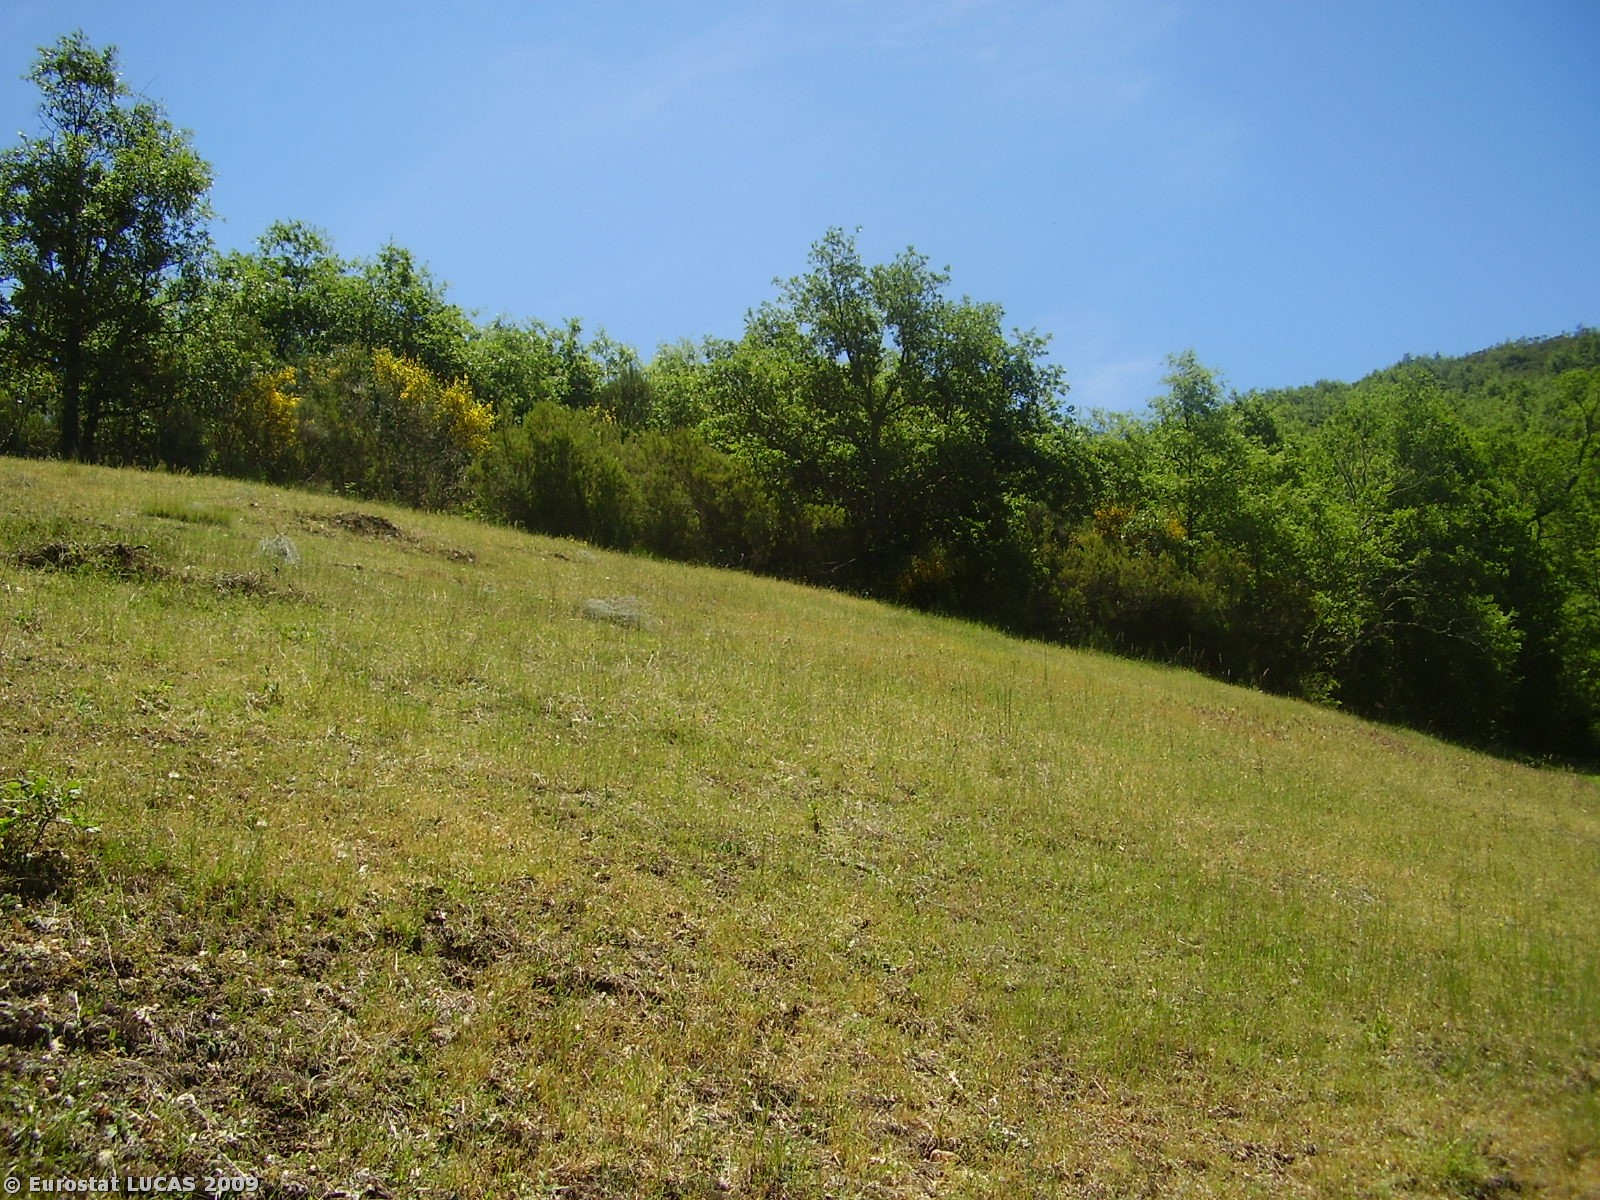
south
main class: Grassland
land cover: Grassland without tree/shrub cover
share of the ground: > 75 %
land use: Agriculture (excluding fallow land and kitchen gardens)
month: June
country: PT
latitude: 41.7177
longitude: -6.9072
